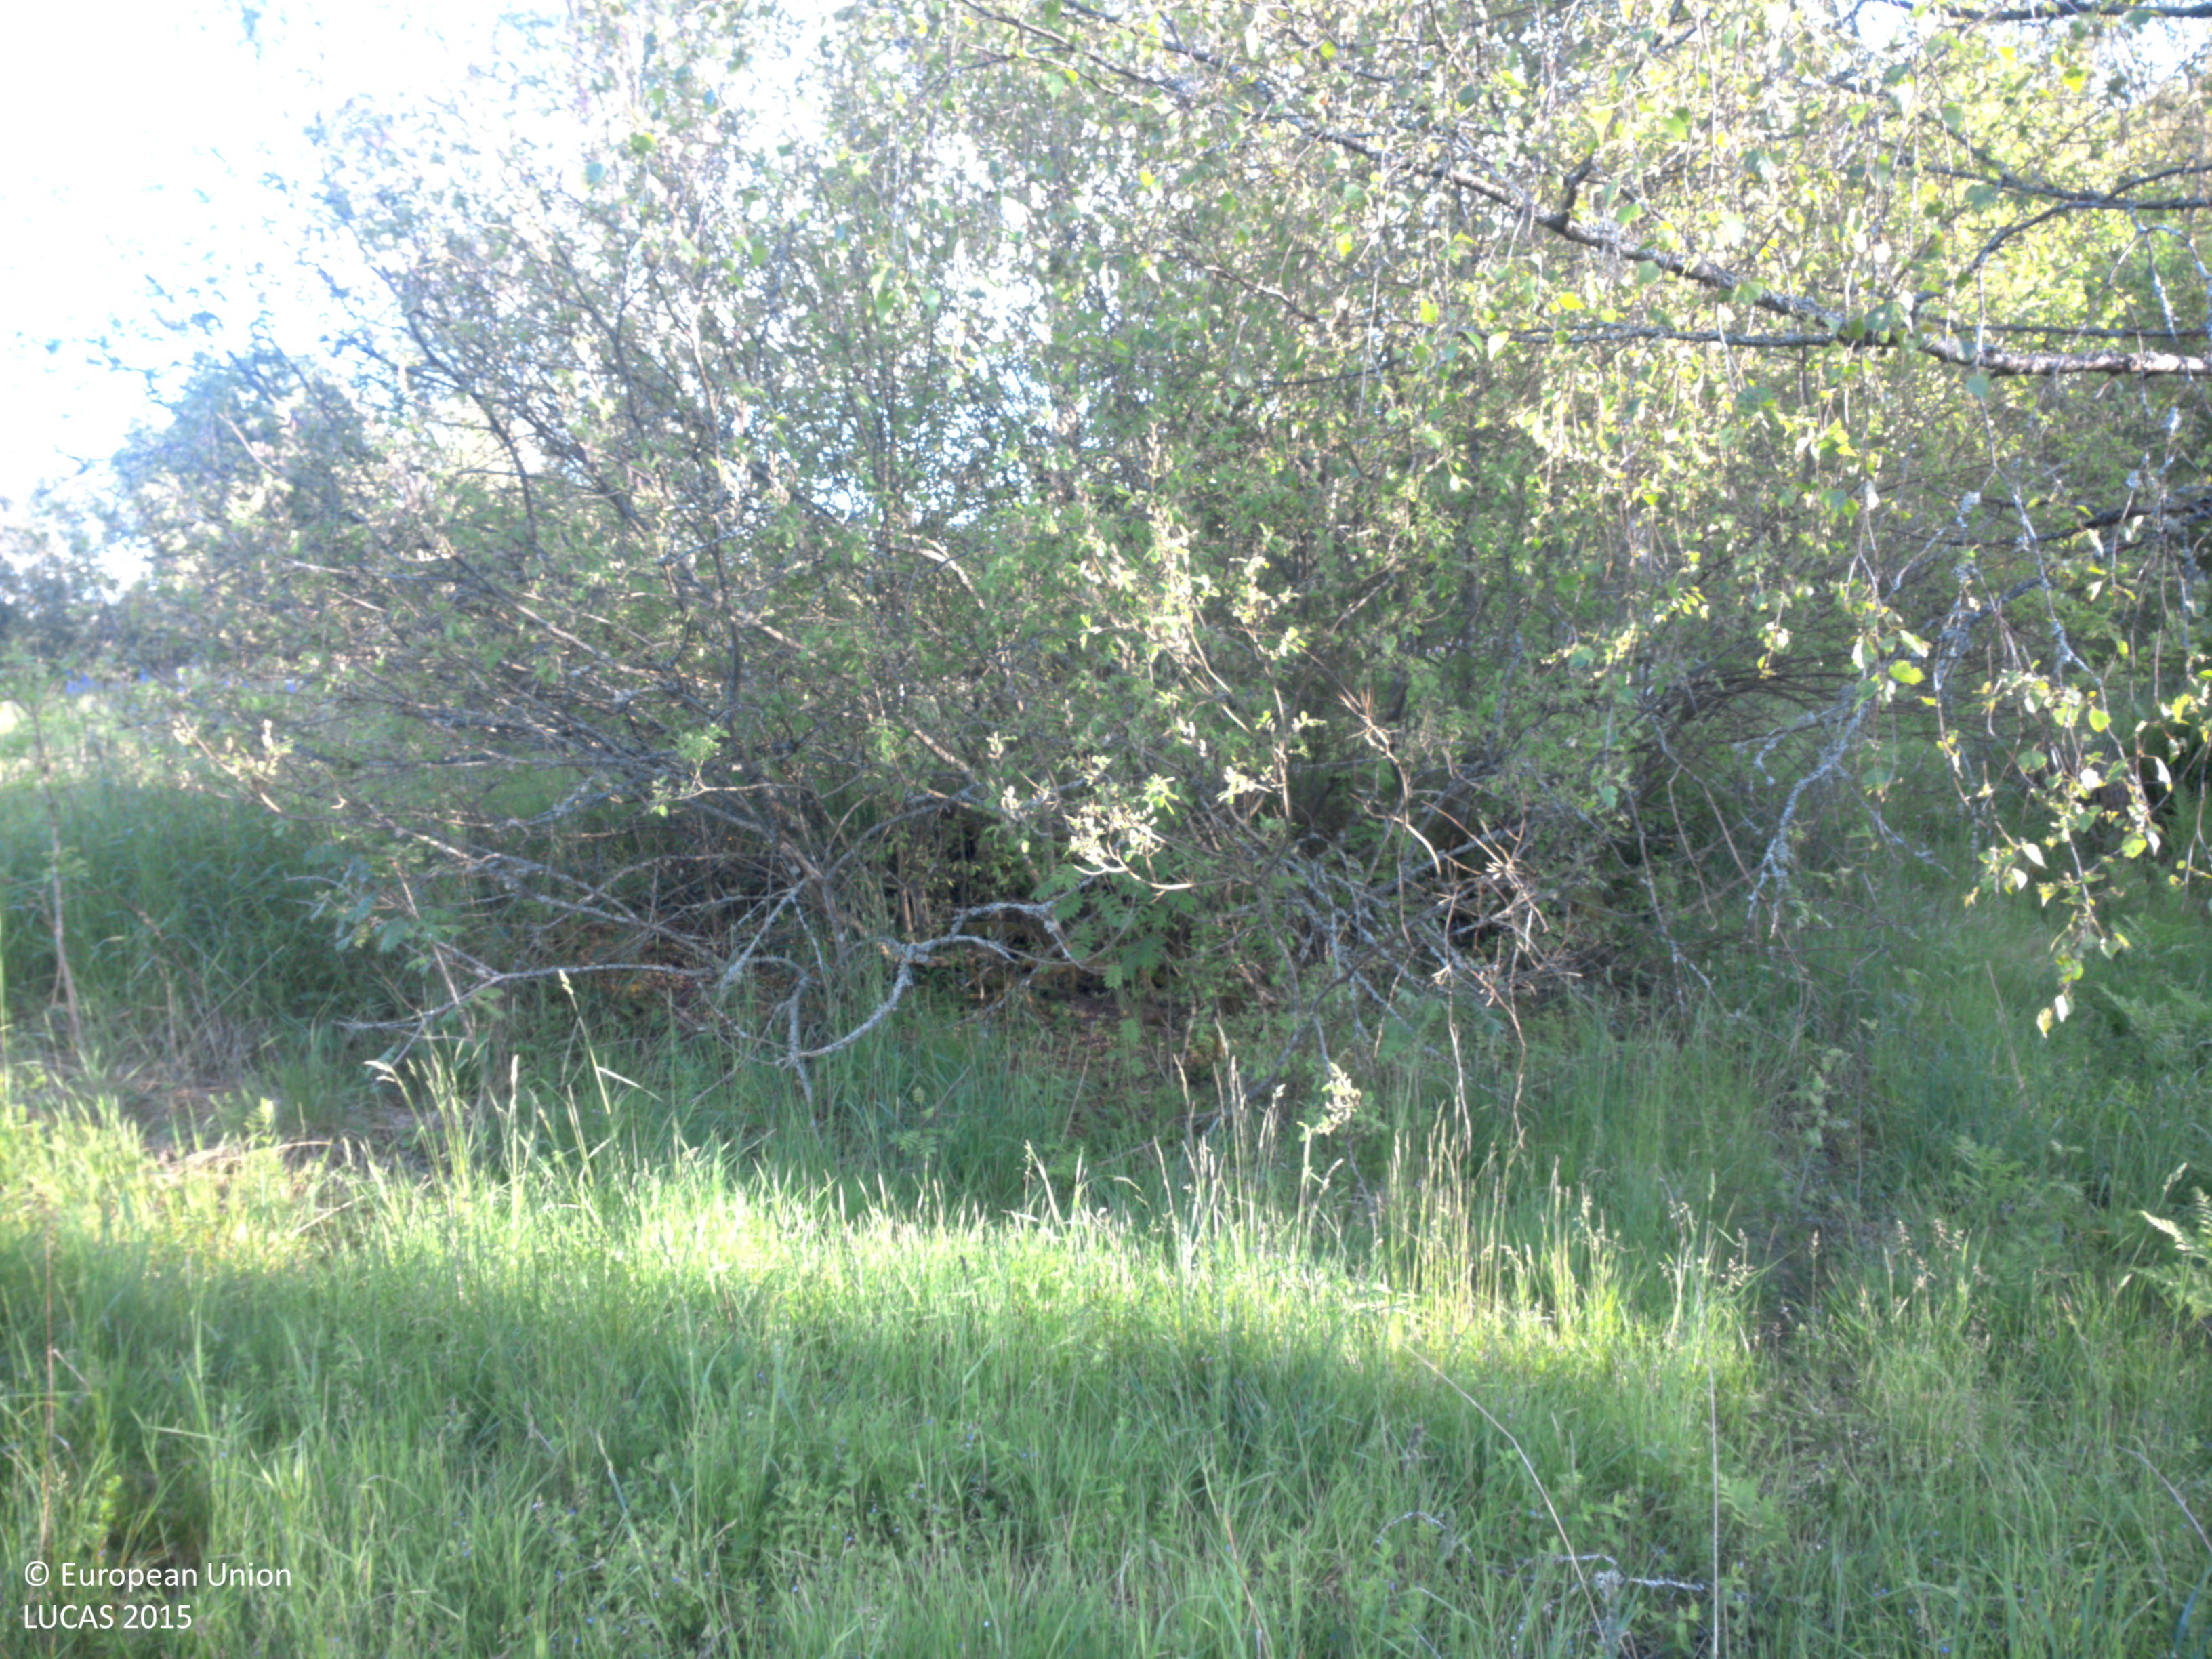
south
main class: Grassland
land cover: Spontaneously vegetated surfaces
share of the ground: > 75 %
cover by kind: herbaceous plants 95 %, shrubs 5 %
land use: Fallow land
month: June
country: SE
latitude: 58.9628
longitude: 11.8215
